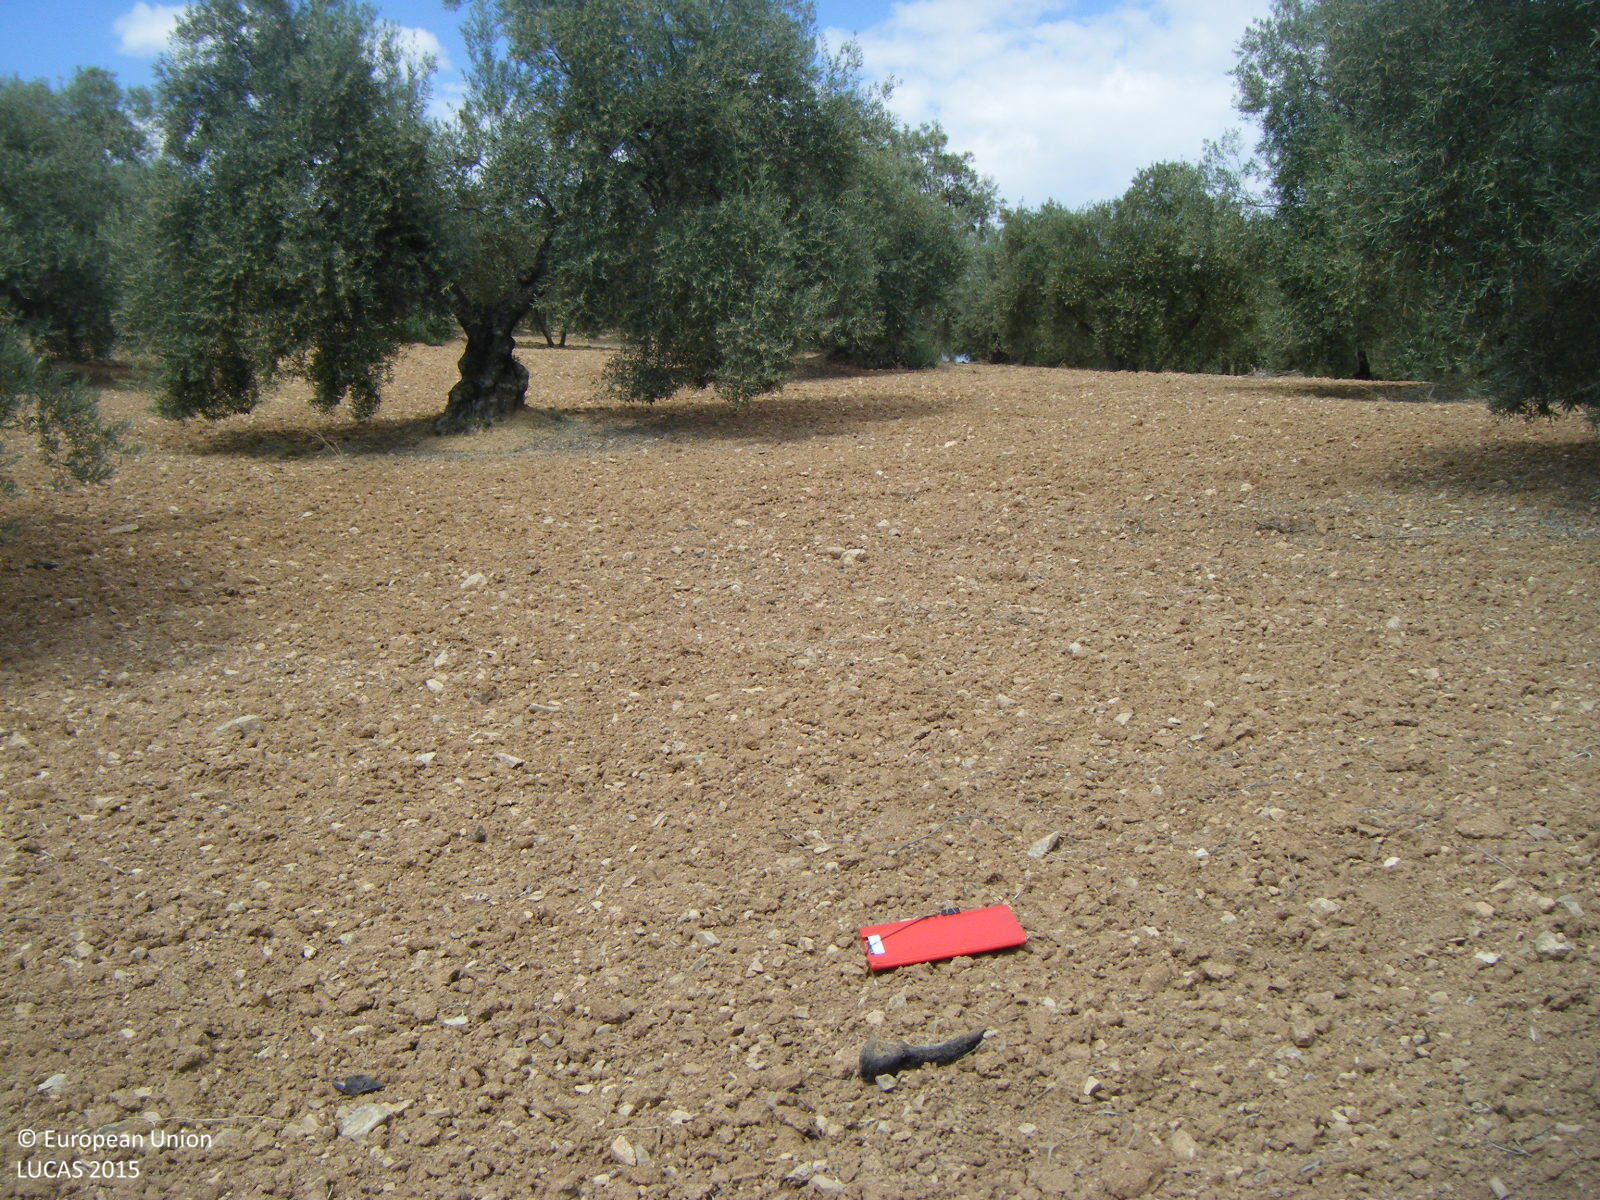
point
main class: Cropland
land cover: Olive groves
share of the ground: 10 - 25 %
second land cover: Other bare soil
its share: > 75 %
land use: Agriculture (excluding fallow land and kitchen gardens)
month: May
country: ES
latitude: 37.2068
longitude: -4.4551
